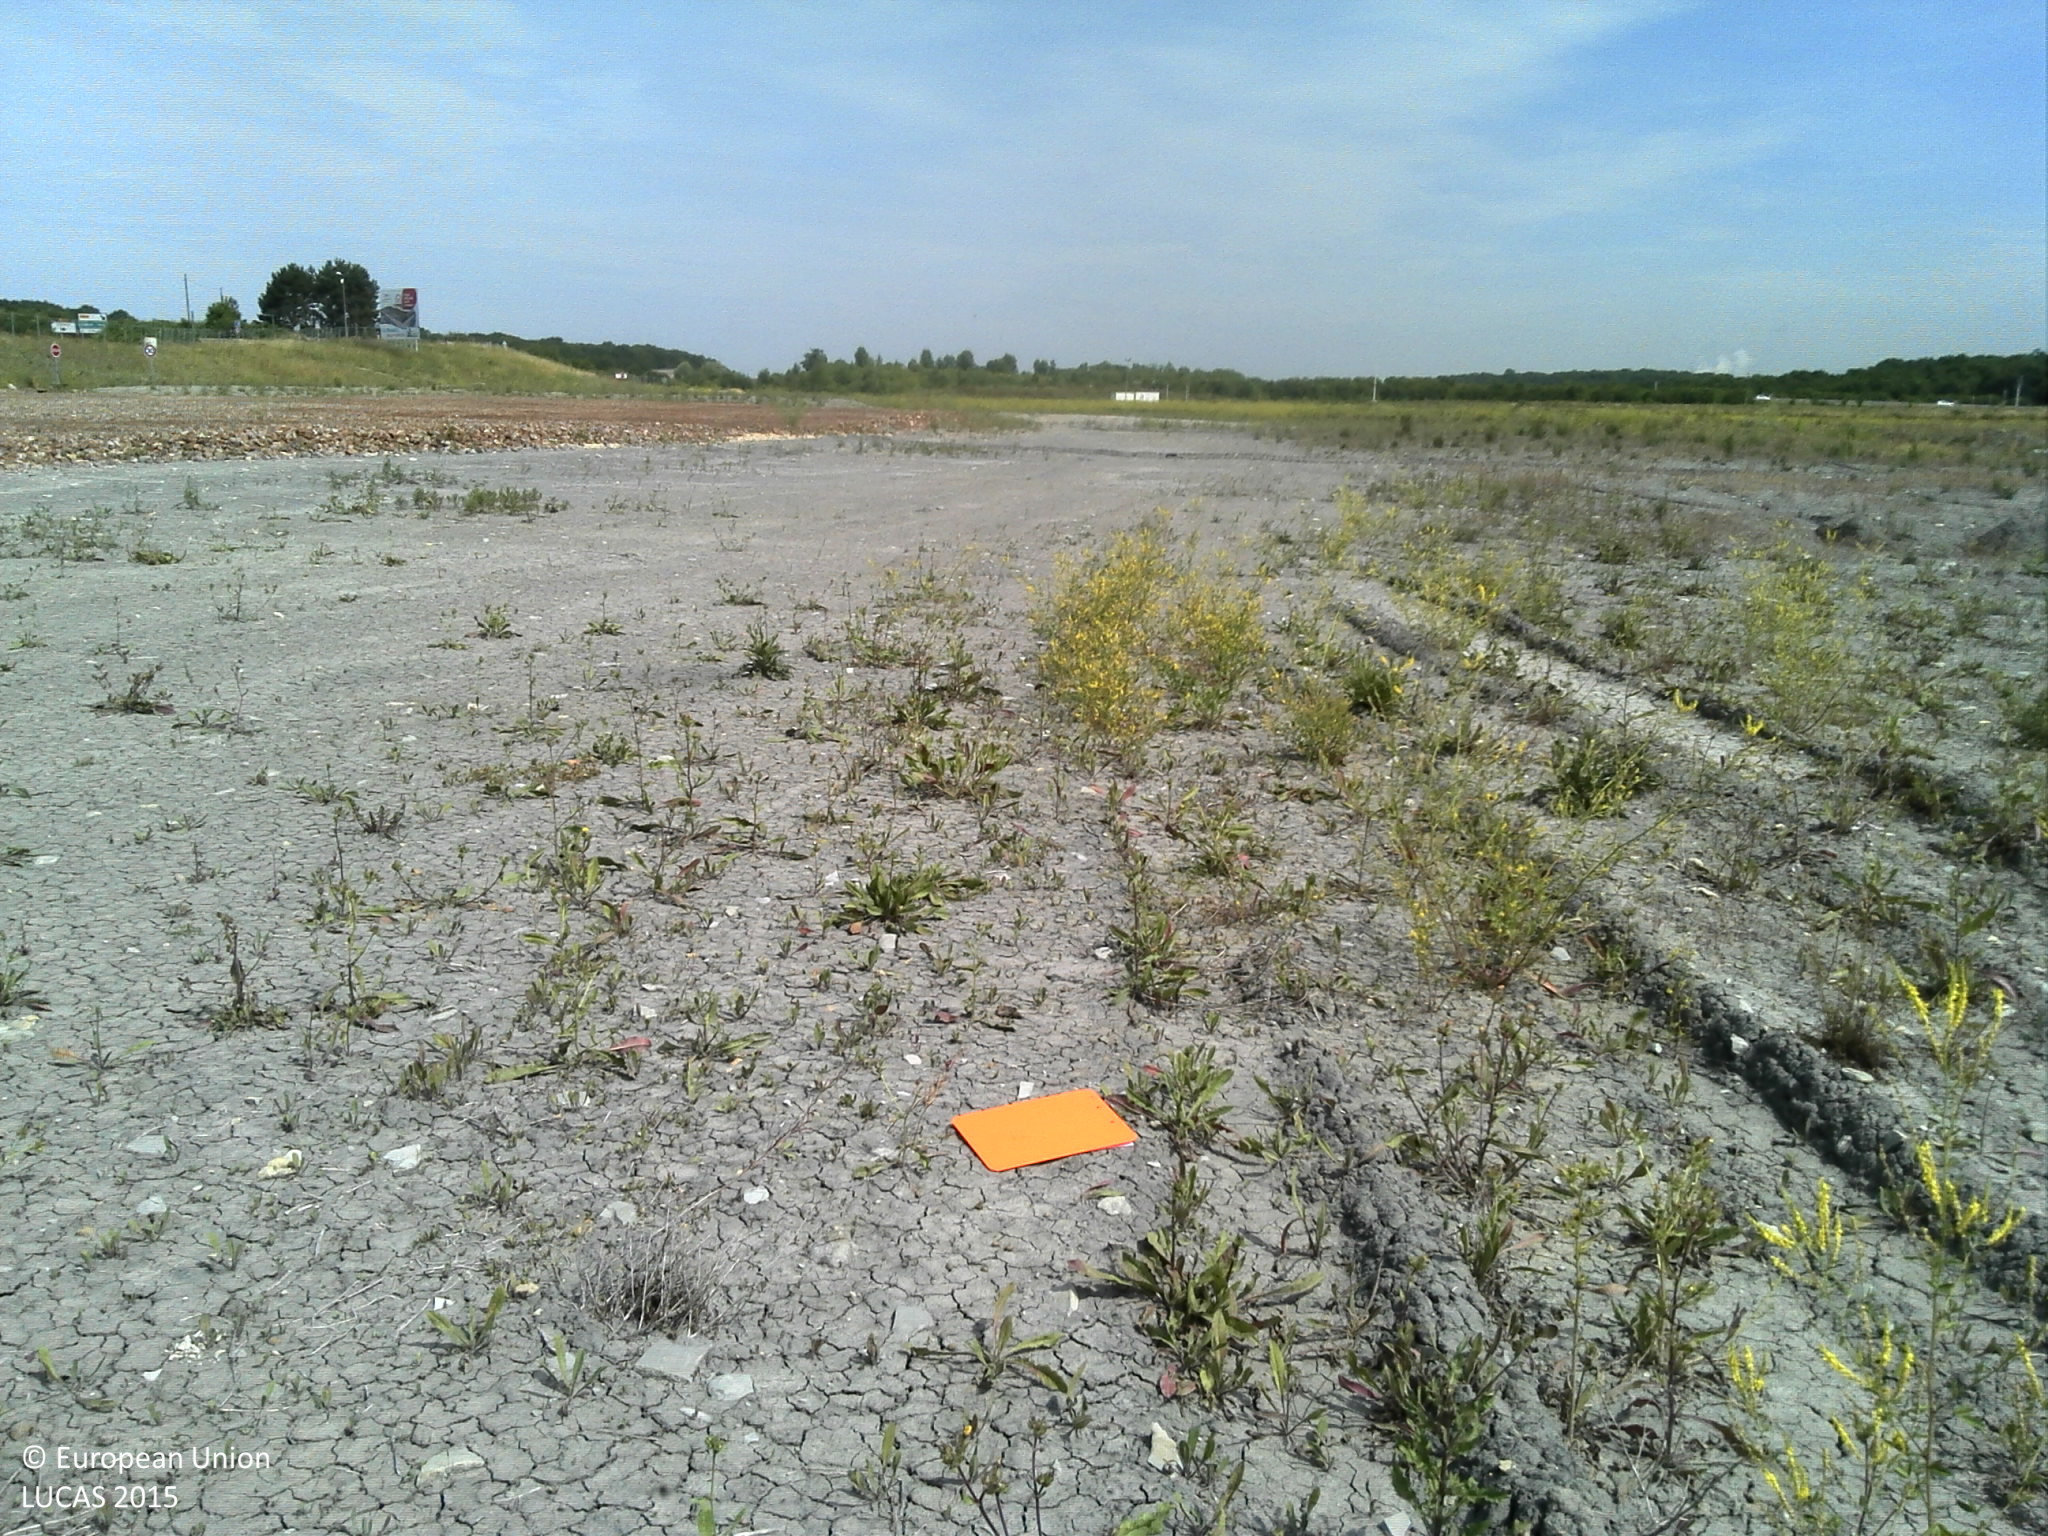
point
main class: Grassland
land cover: Spontaneously vegetated surfaces
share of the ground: 25 - 50 %
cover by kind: unconsolidated bare surface 60 %, herbaceous plants 40 %
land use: Semi-natural and natural areas not in use
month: June
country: FR
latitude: 49.3284
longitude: 6.1882
